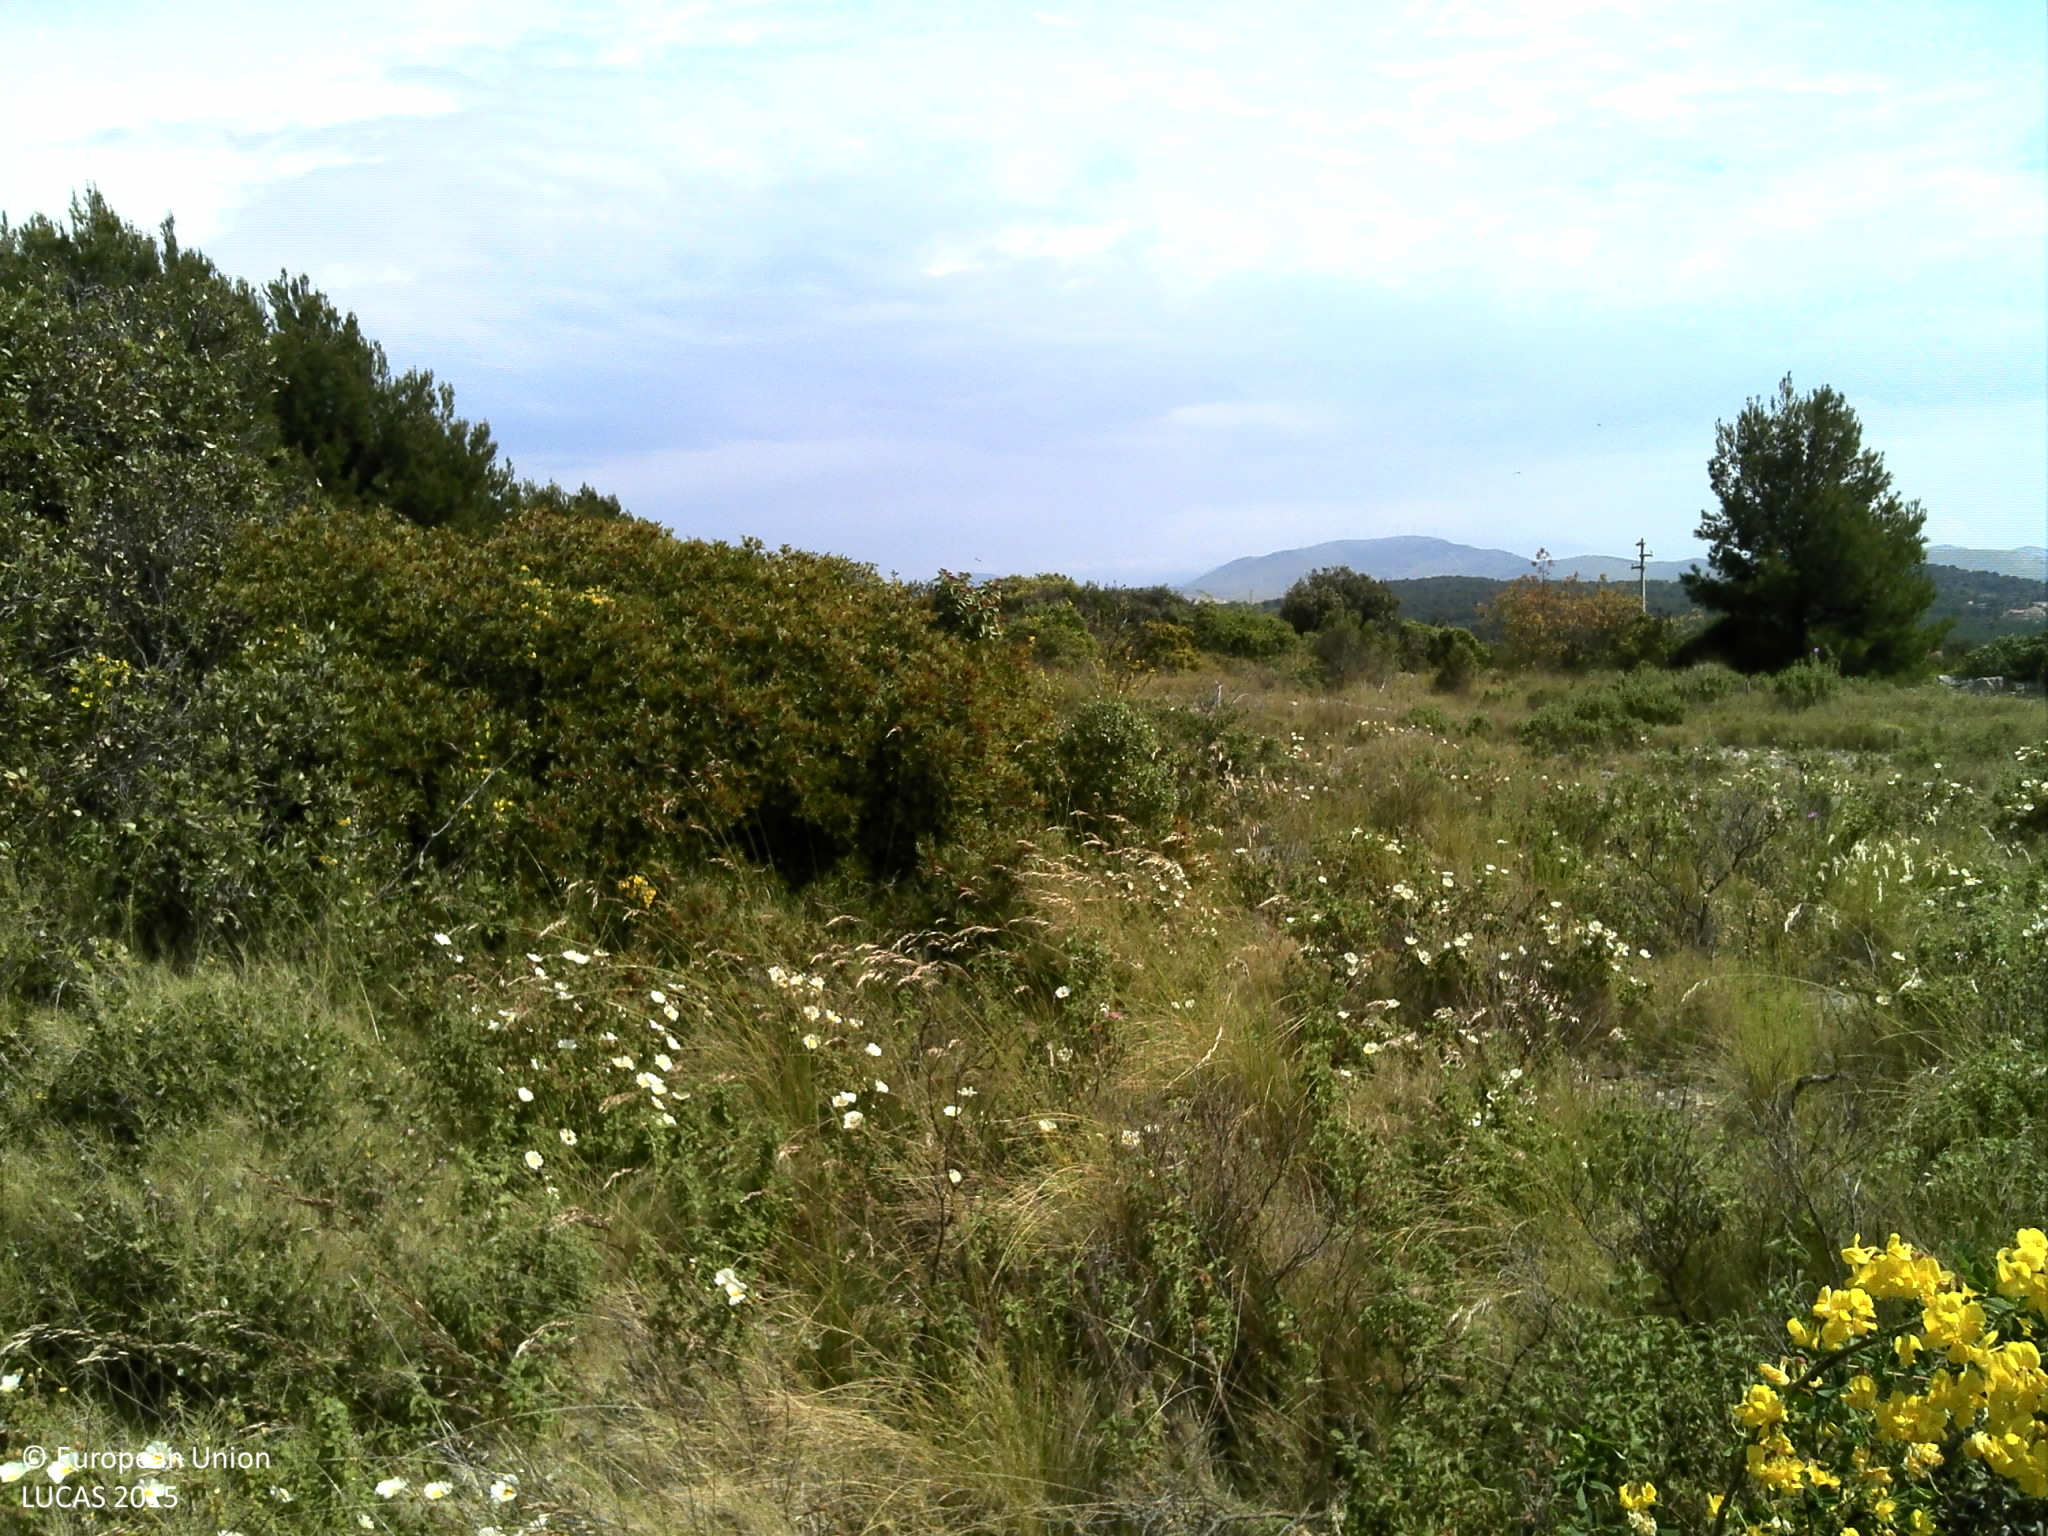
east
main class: Shrubland
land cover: Shrubland with sparse tree cover
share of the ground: 25 - 50 %
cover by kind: shrubs 35 %, herbaceous plants 30 %, consolidated bare surface 15 %, unconsolidated bare surface 15 %, coniferous forest trees 5 %
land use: Semi-natural and natural areas not in use
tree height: < 5 m
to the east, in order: Shrubland with sparse tree cover; Pine dominated coniferous woodland; Tracks; Shrubland with sparse tree cover; Dry stone walls; Shrubland with sparse tree cover; Fences; Shrubland with sparse tree cover
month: April
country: HR
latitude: 43.6939
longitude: 15.9092
